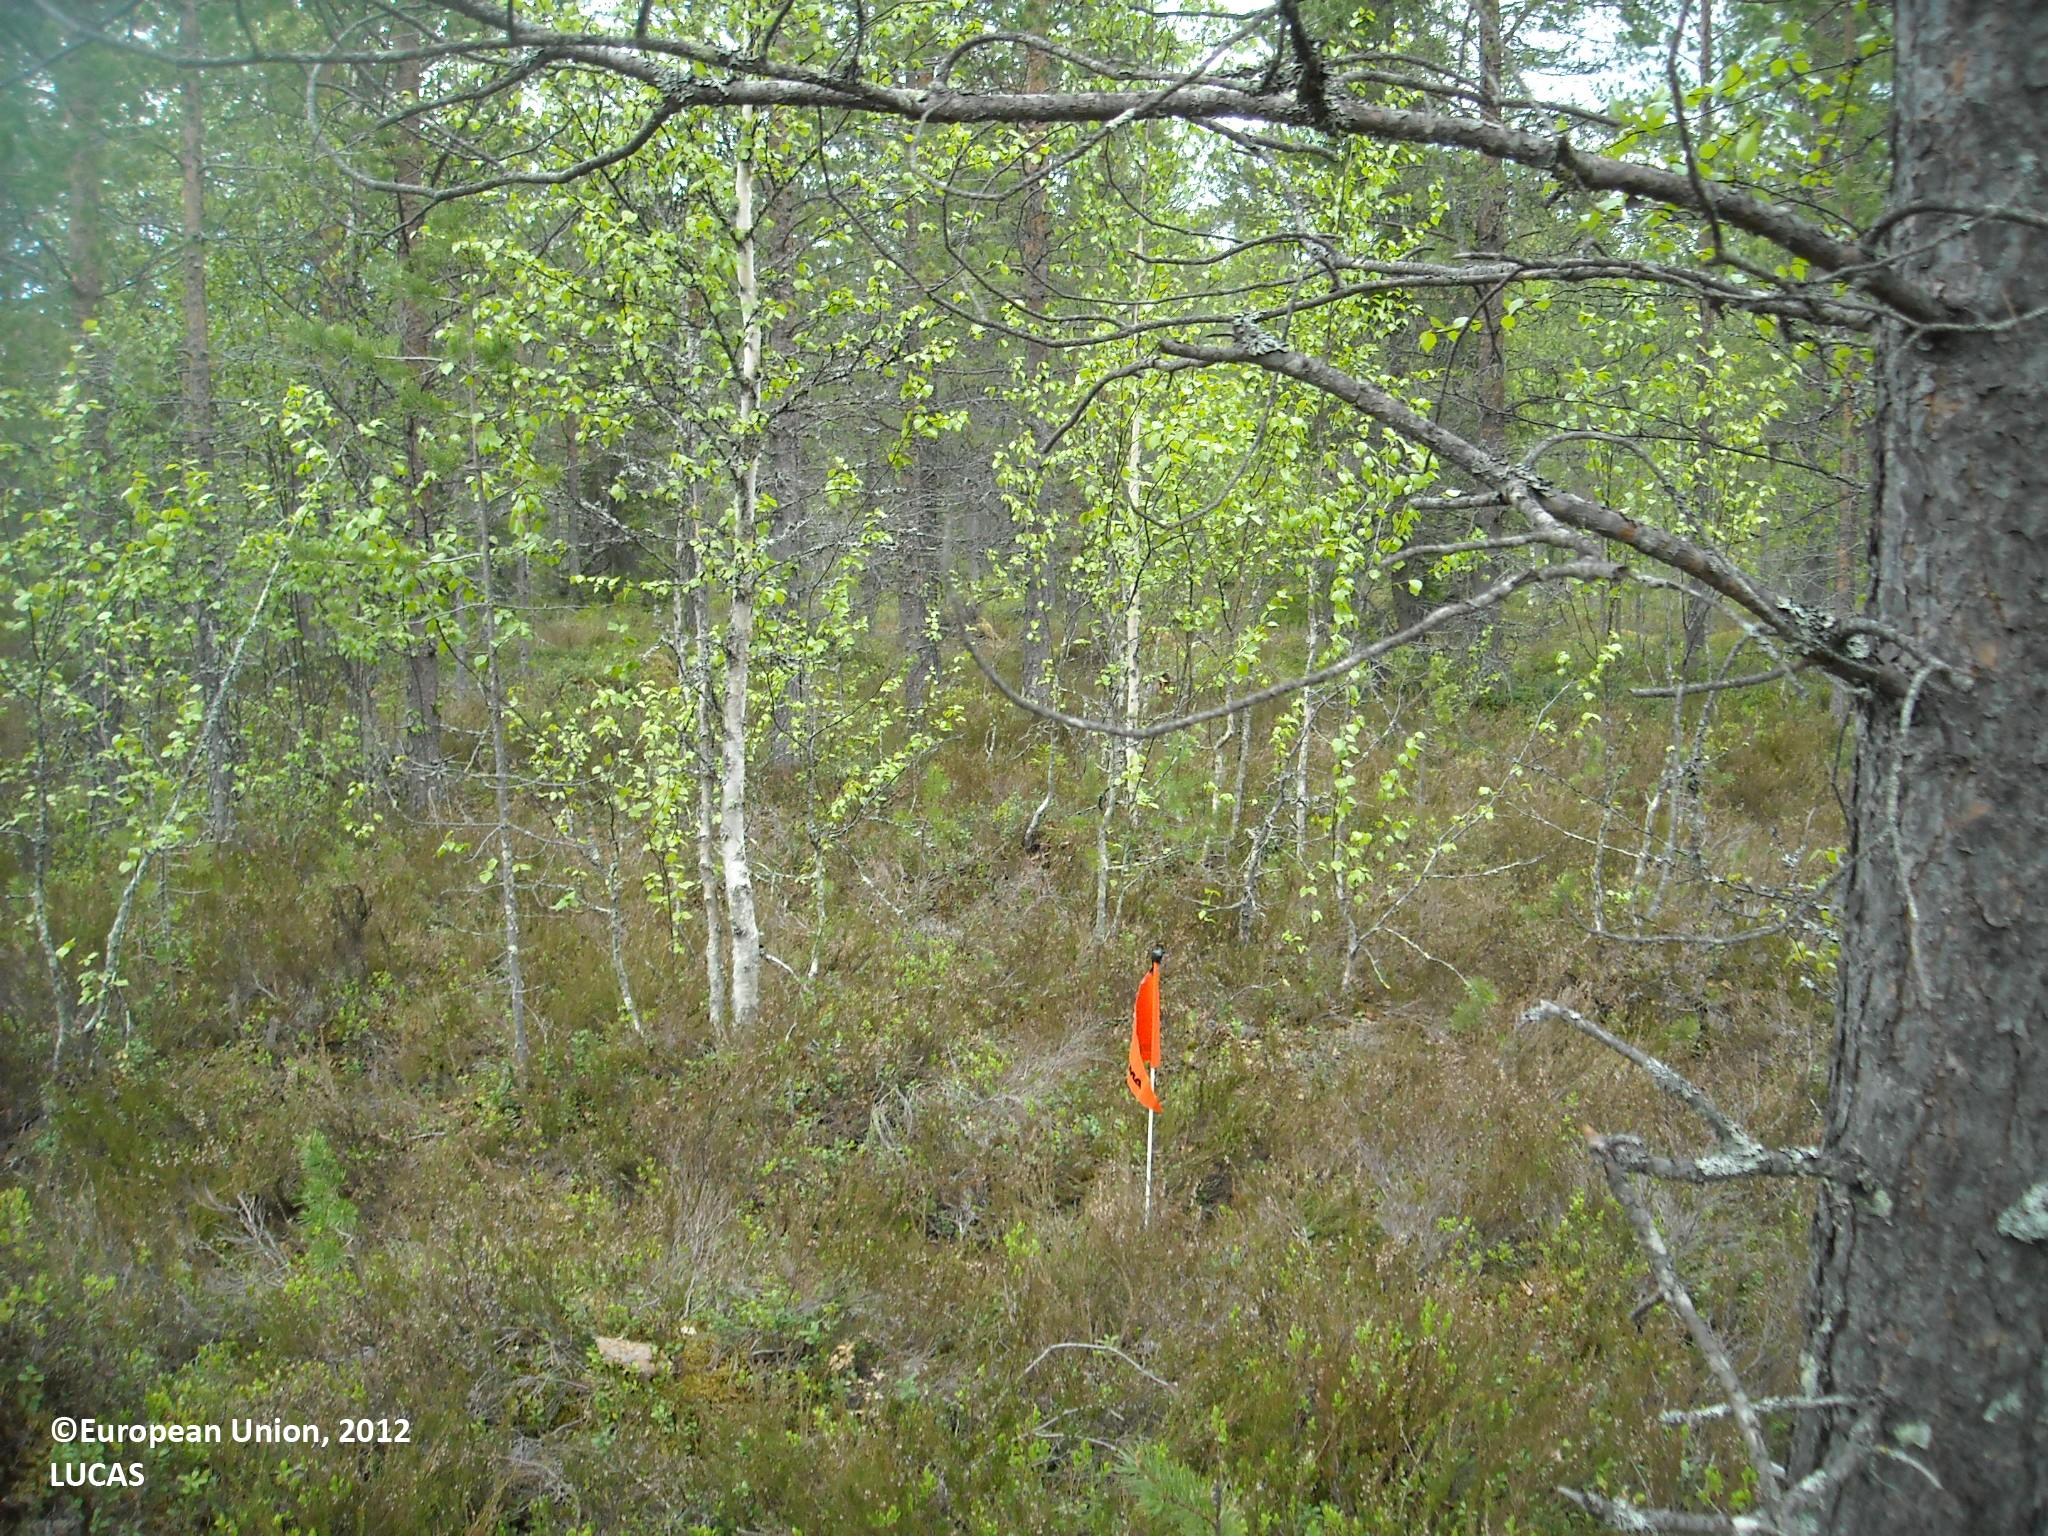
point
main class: Woodland
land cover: Pine dominated mixed woodland
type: boreal forest
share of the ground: > 75 %
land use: Forestry
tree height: > 5 m
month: June
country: FI
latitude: 65.2599
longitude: 27.8095
